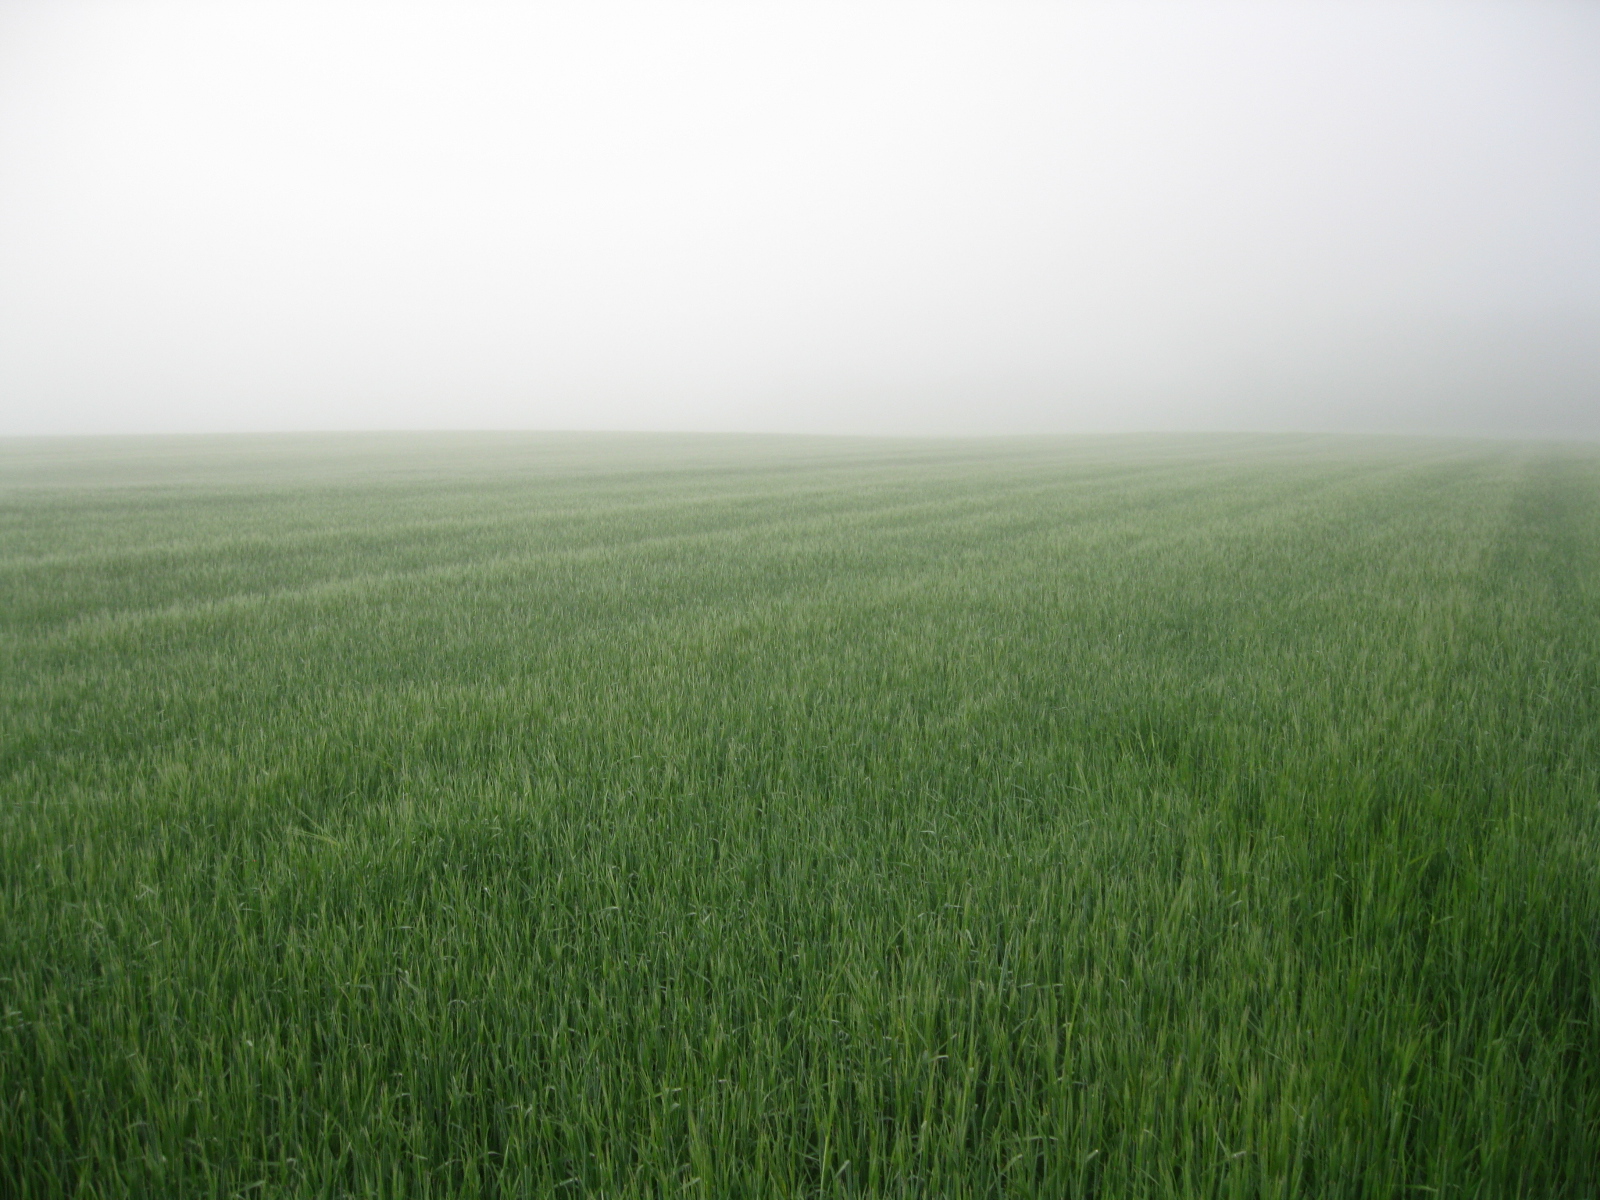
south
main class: Cropland
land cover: Barley
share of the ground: > 75 %
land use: Agriculture (excluding fallow land and kitchen gardens)
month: June
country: LT
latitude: 55.4740
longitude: 23.9628
